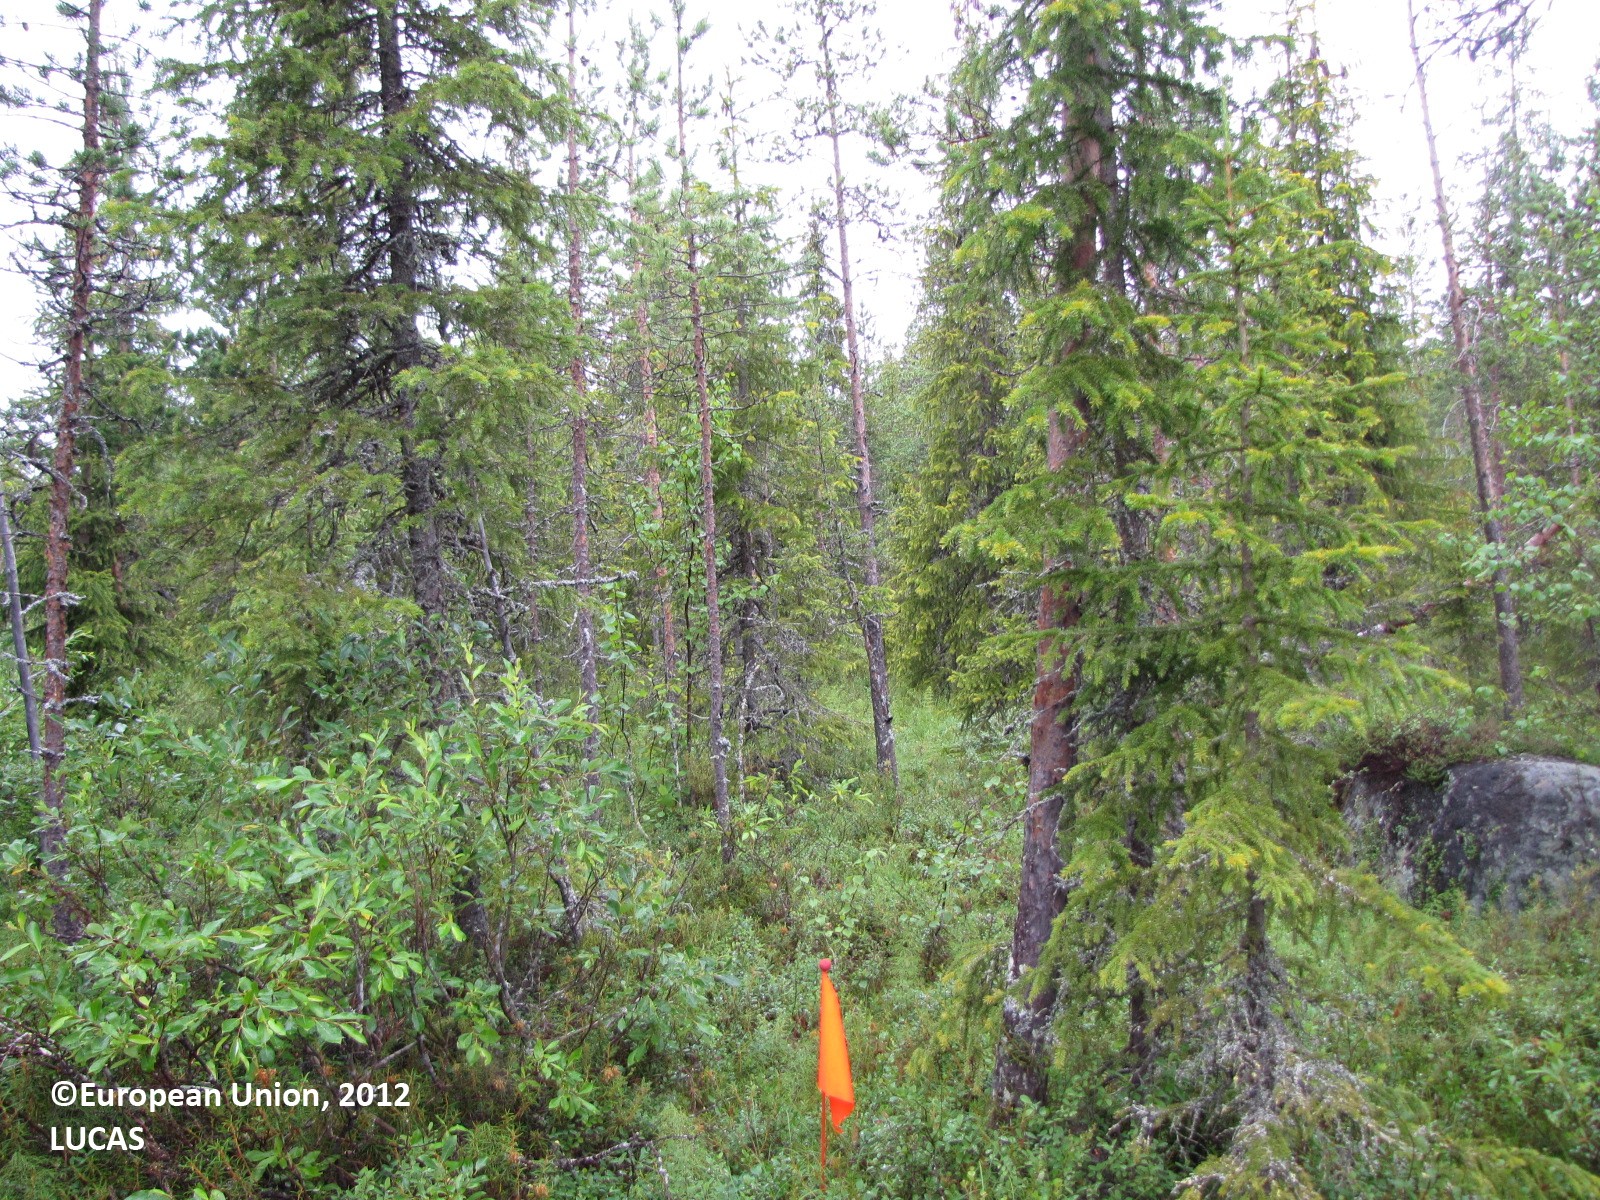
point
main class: Woodland
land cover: Other mixed woodland
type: boreal forest
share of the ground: 50 - 75 %
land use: Forestry
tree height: > 5 m
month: July
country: FI
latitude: 66.6220
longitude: 24.7499
